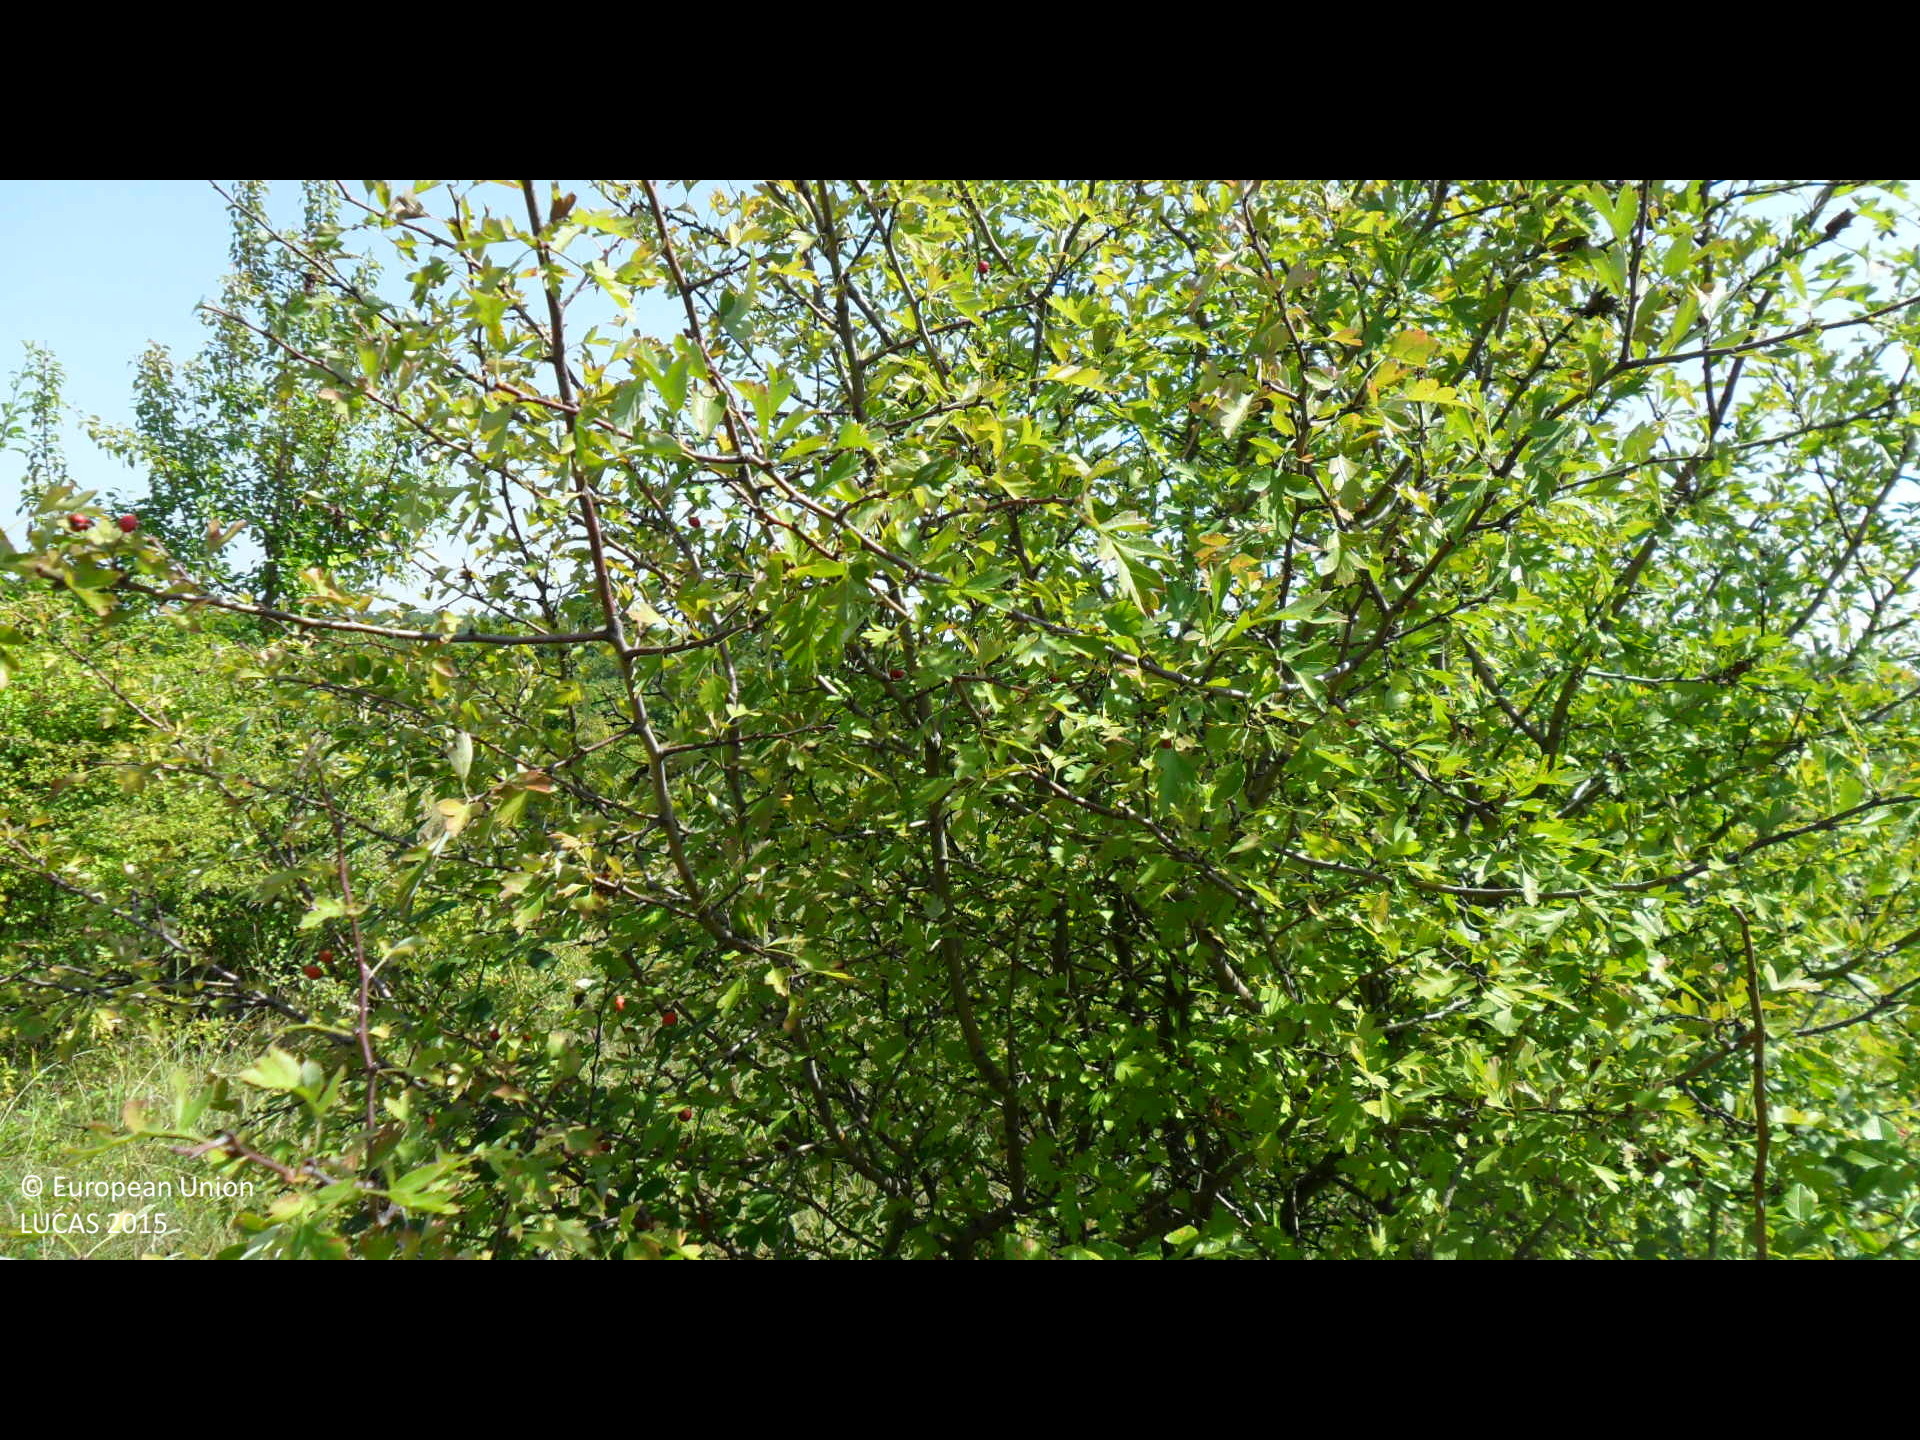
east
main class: Shrubland
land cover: Shrubland without tree cover
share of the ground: > 75 %
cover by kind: shrubs 75 %, herbaceous plants 25 %
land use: Semi-natural and natural areas not in use
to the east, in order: Shrubland without tree cover; Broadleaved woodland; Grassland with sparse tree/shrub cover
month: August
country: BG
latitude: 43.4630
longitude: 26.2526
